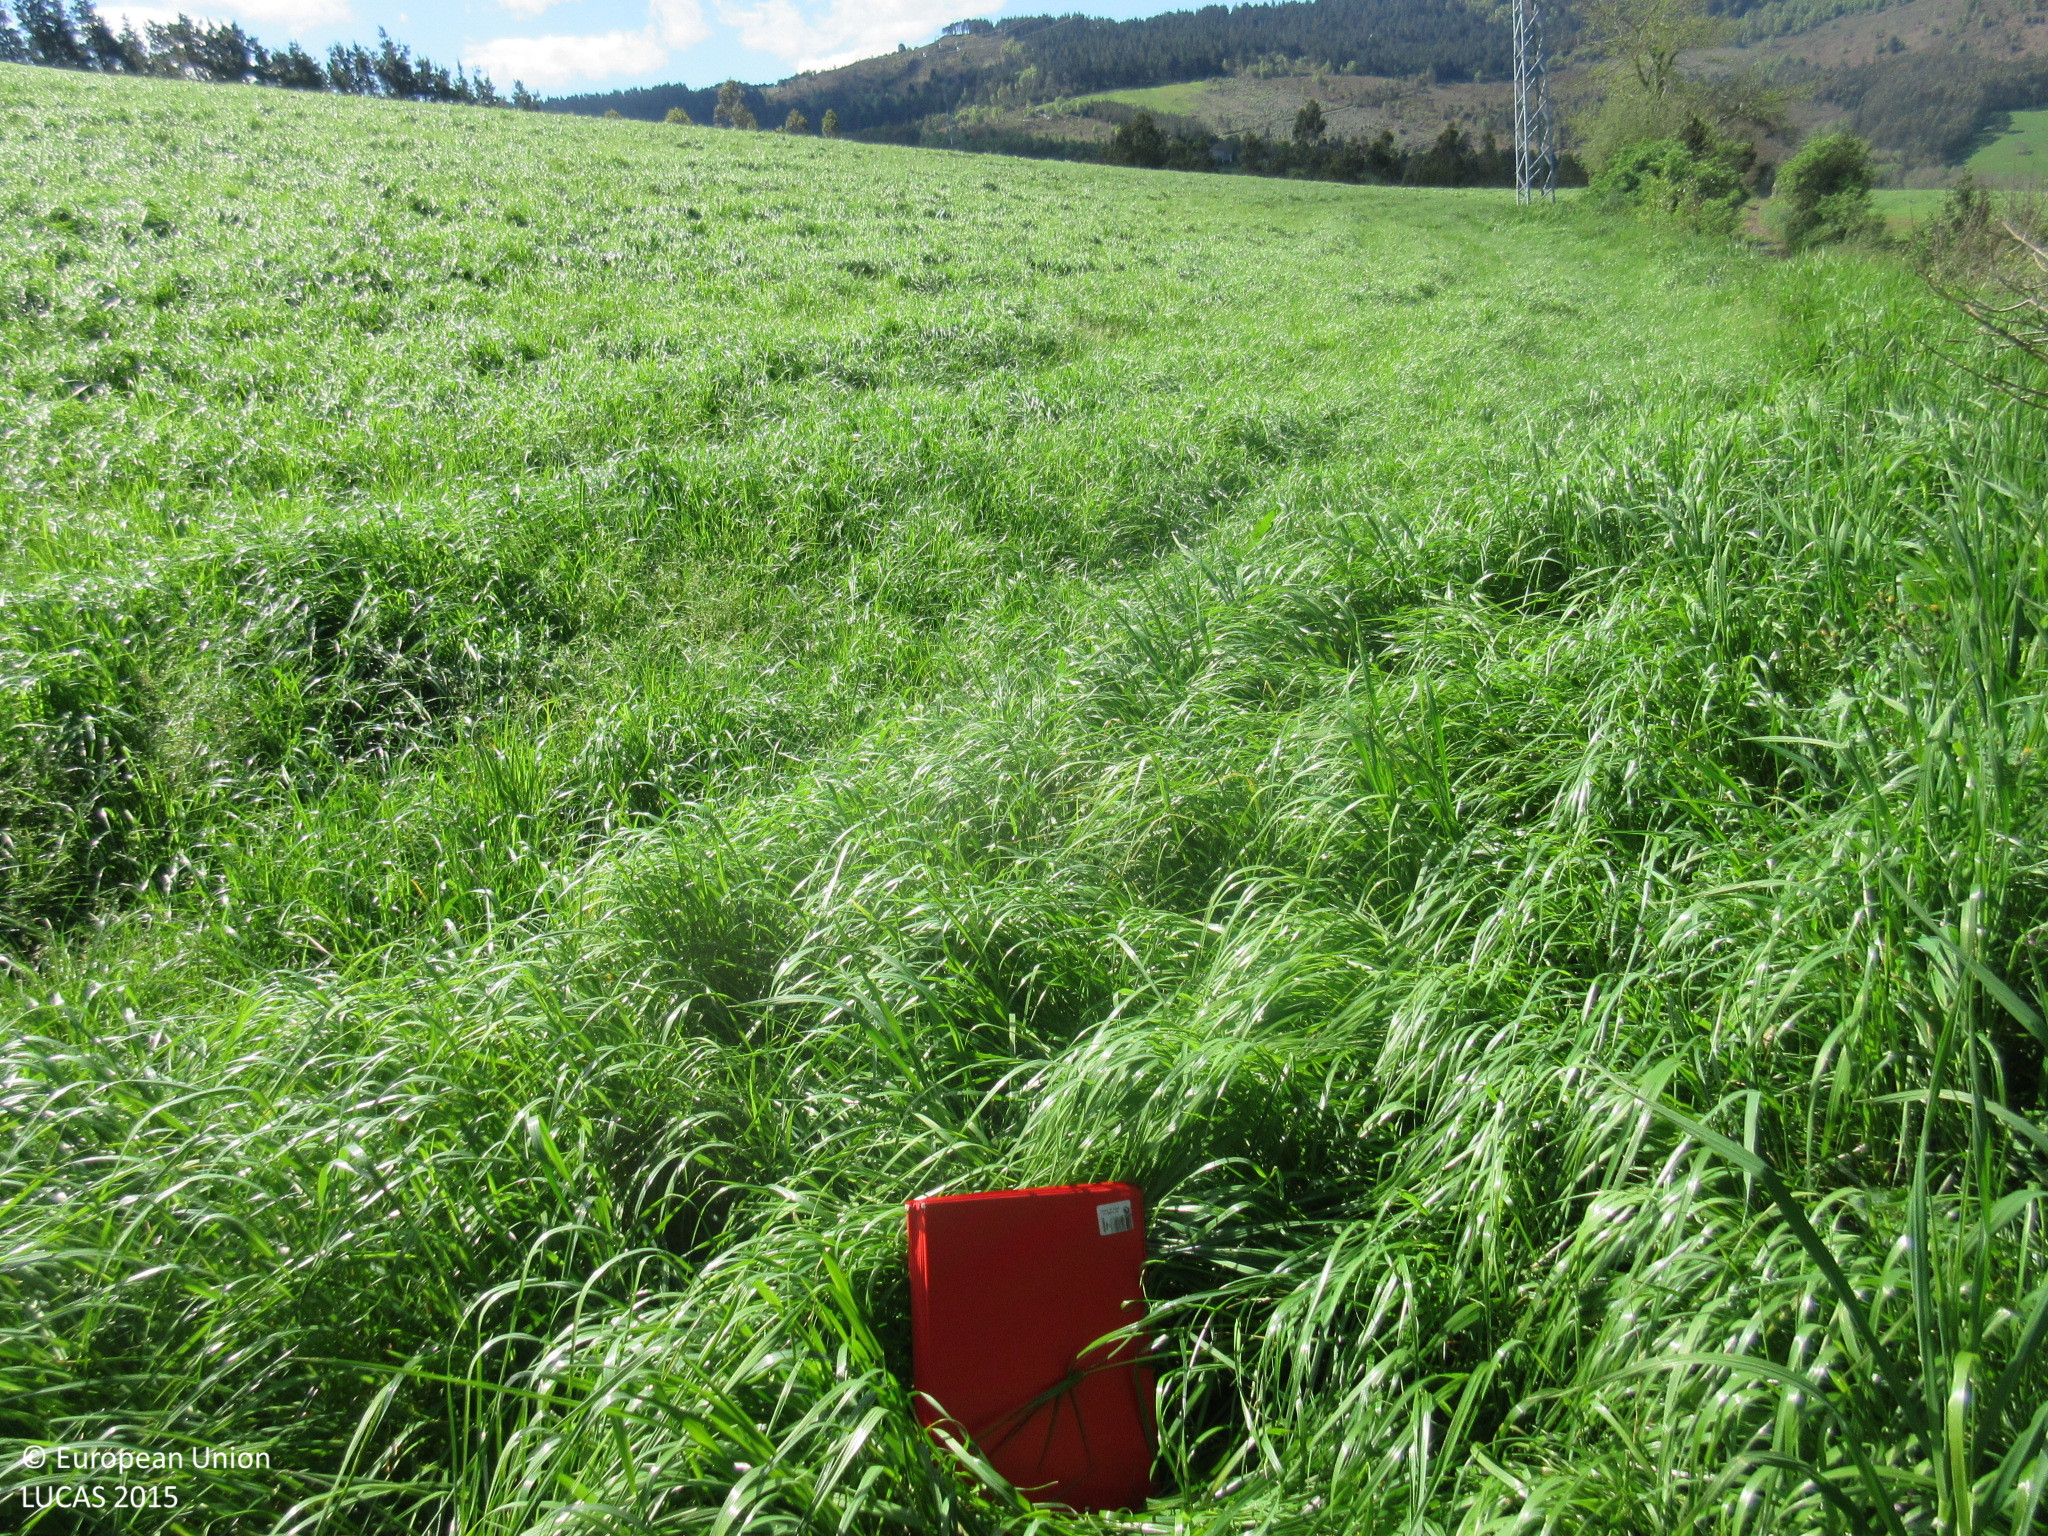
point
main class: Cropland
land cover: Temporary grasslands
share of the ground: > 75 %
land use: Agriculture (excluding fallow land and kitchen gardens)
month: April
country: ES
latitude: 43.4921
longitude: -6.9712
